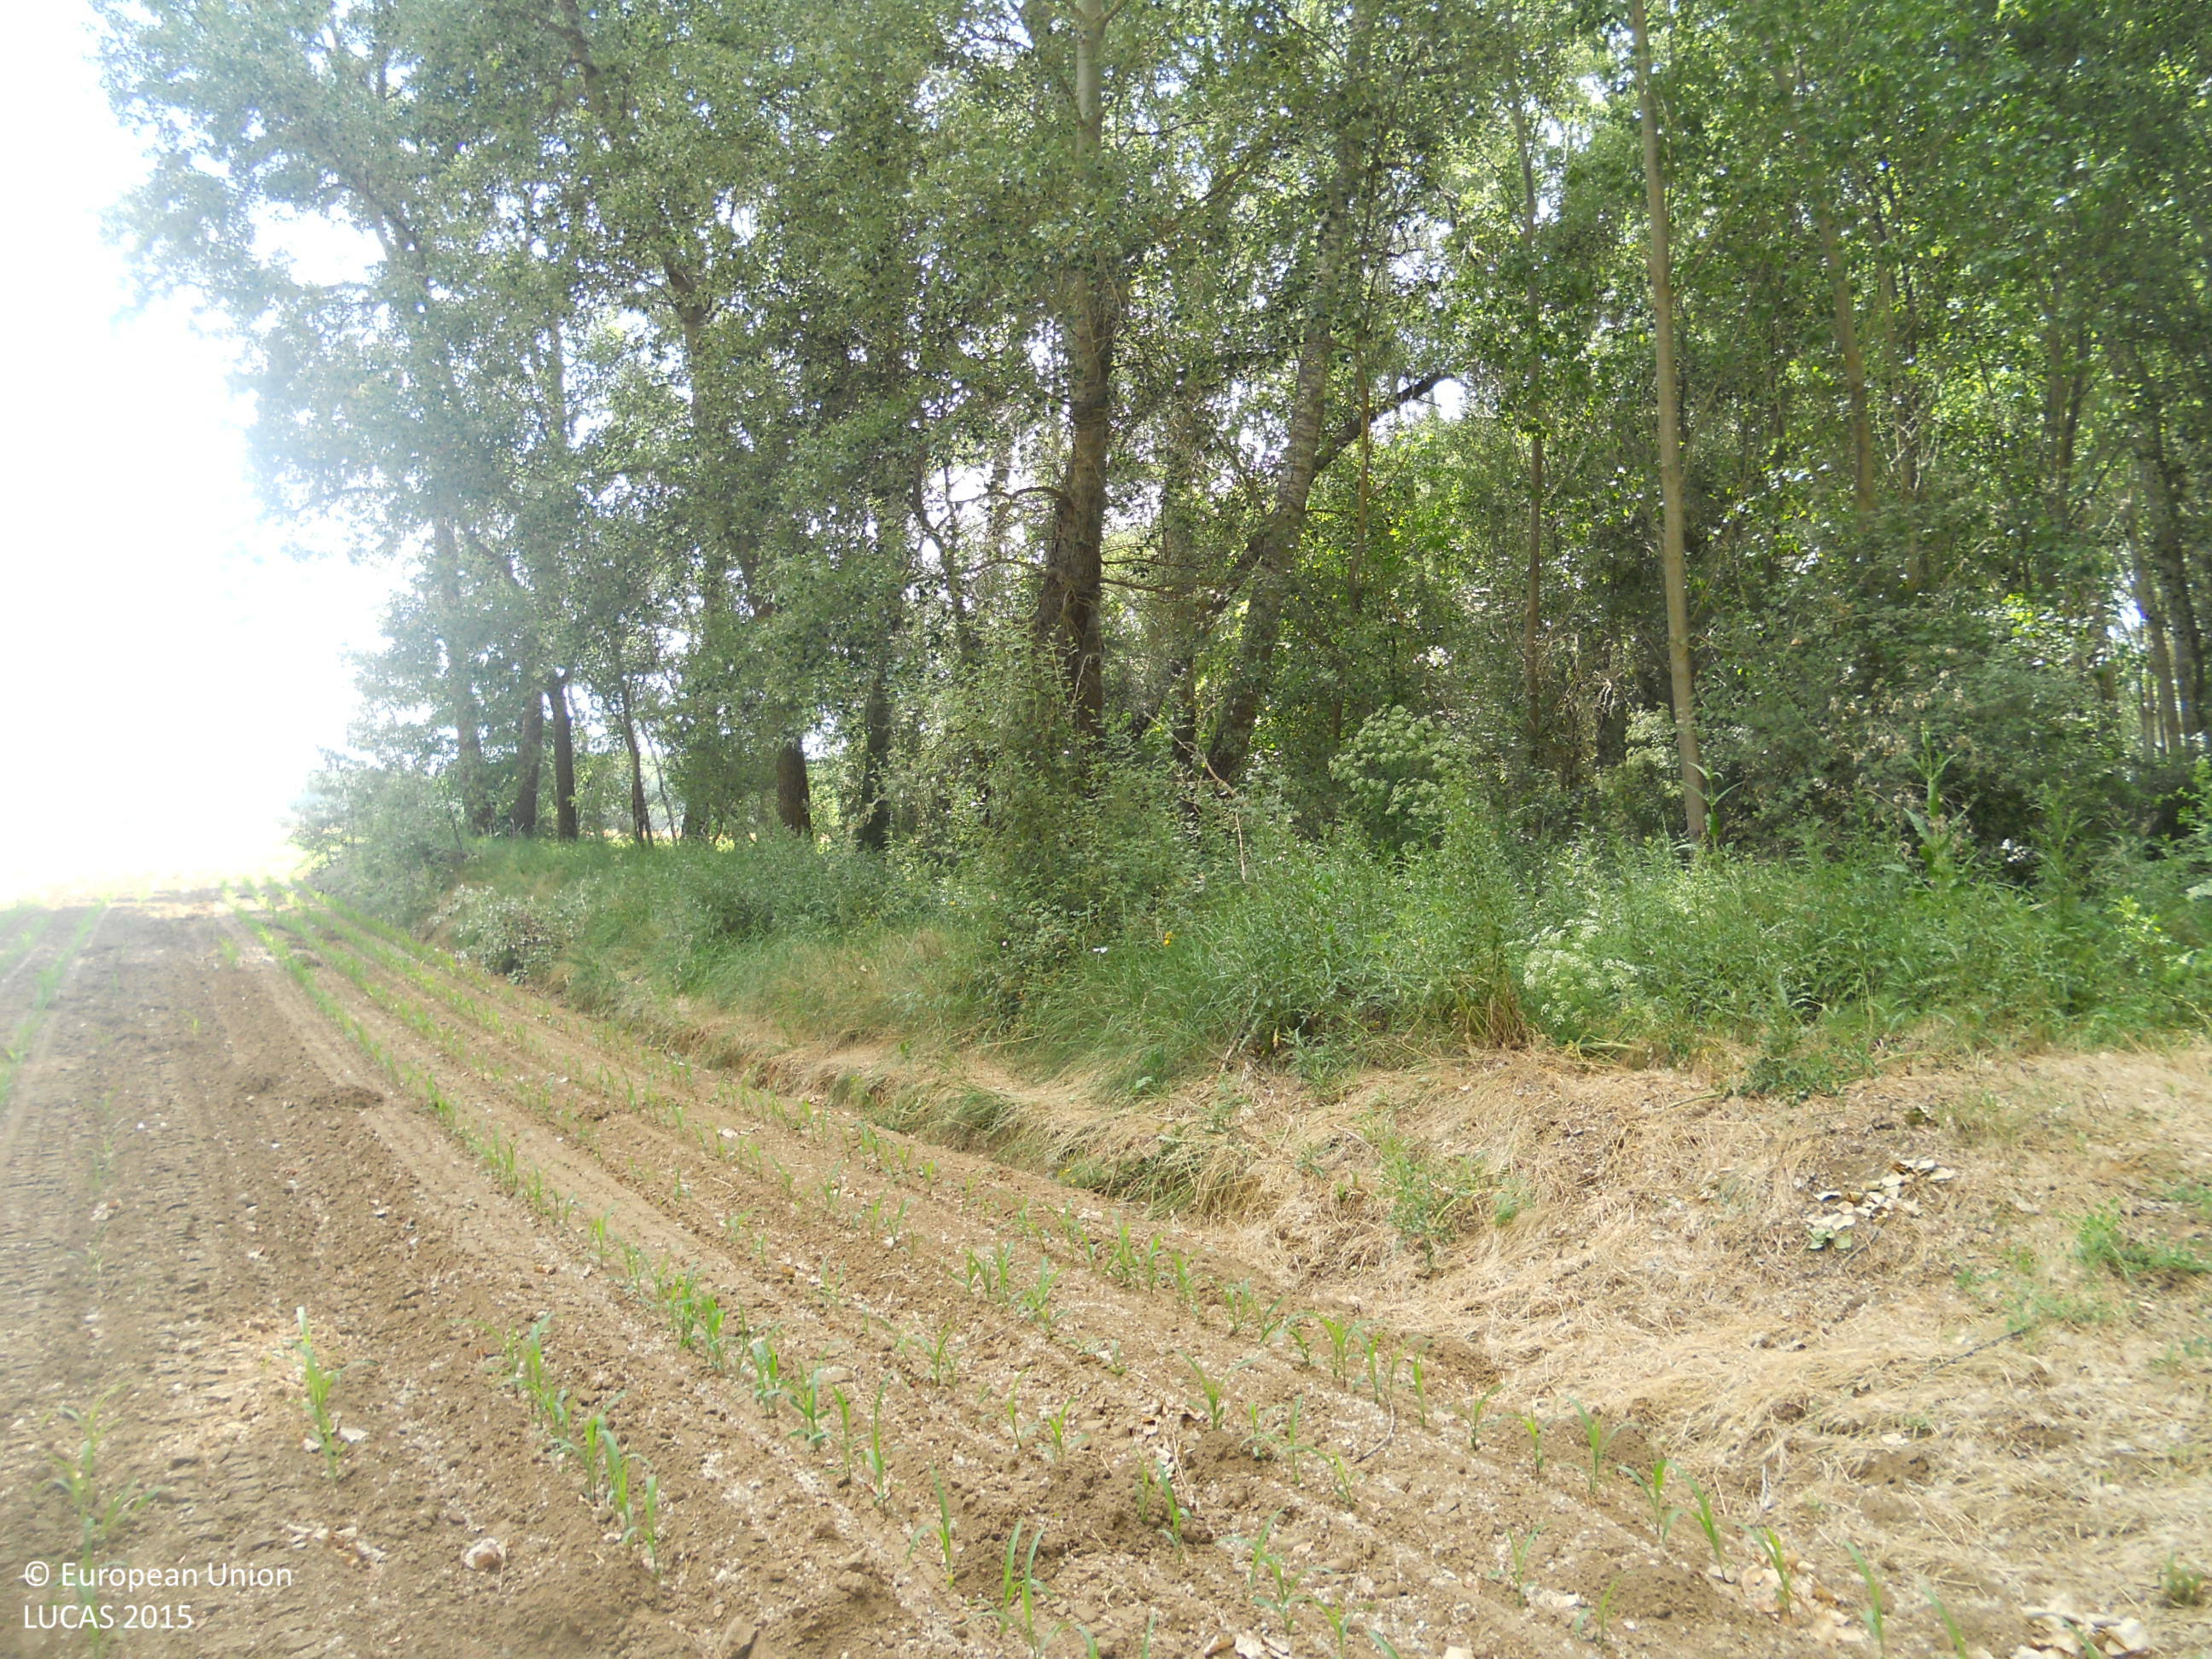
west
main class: Cropland
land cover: Maize
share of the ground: < 10 %
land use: Agriculture (excluding fallow land and kitchen gardens)
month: June
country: ES
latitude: 42.1962
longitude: -5.5564
